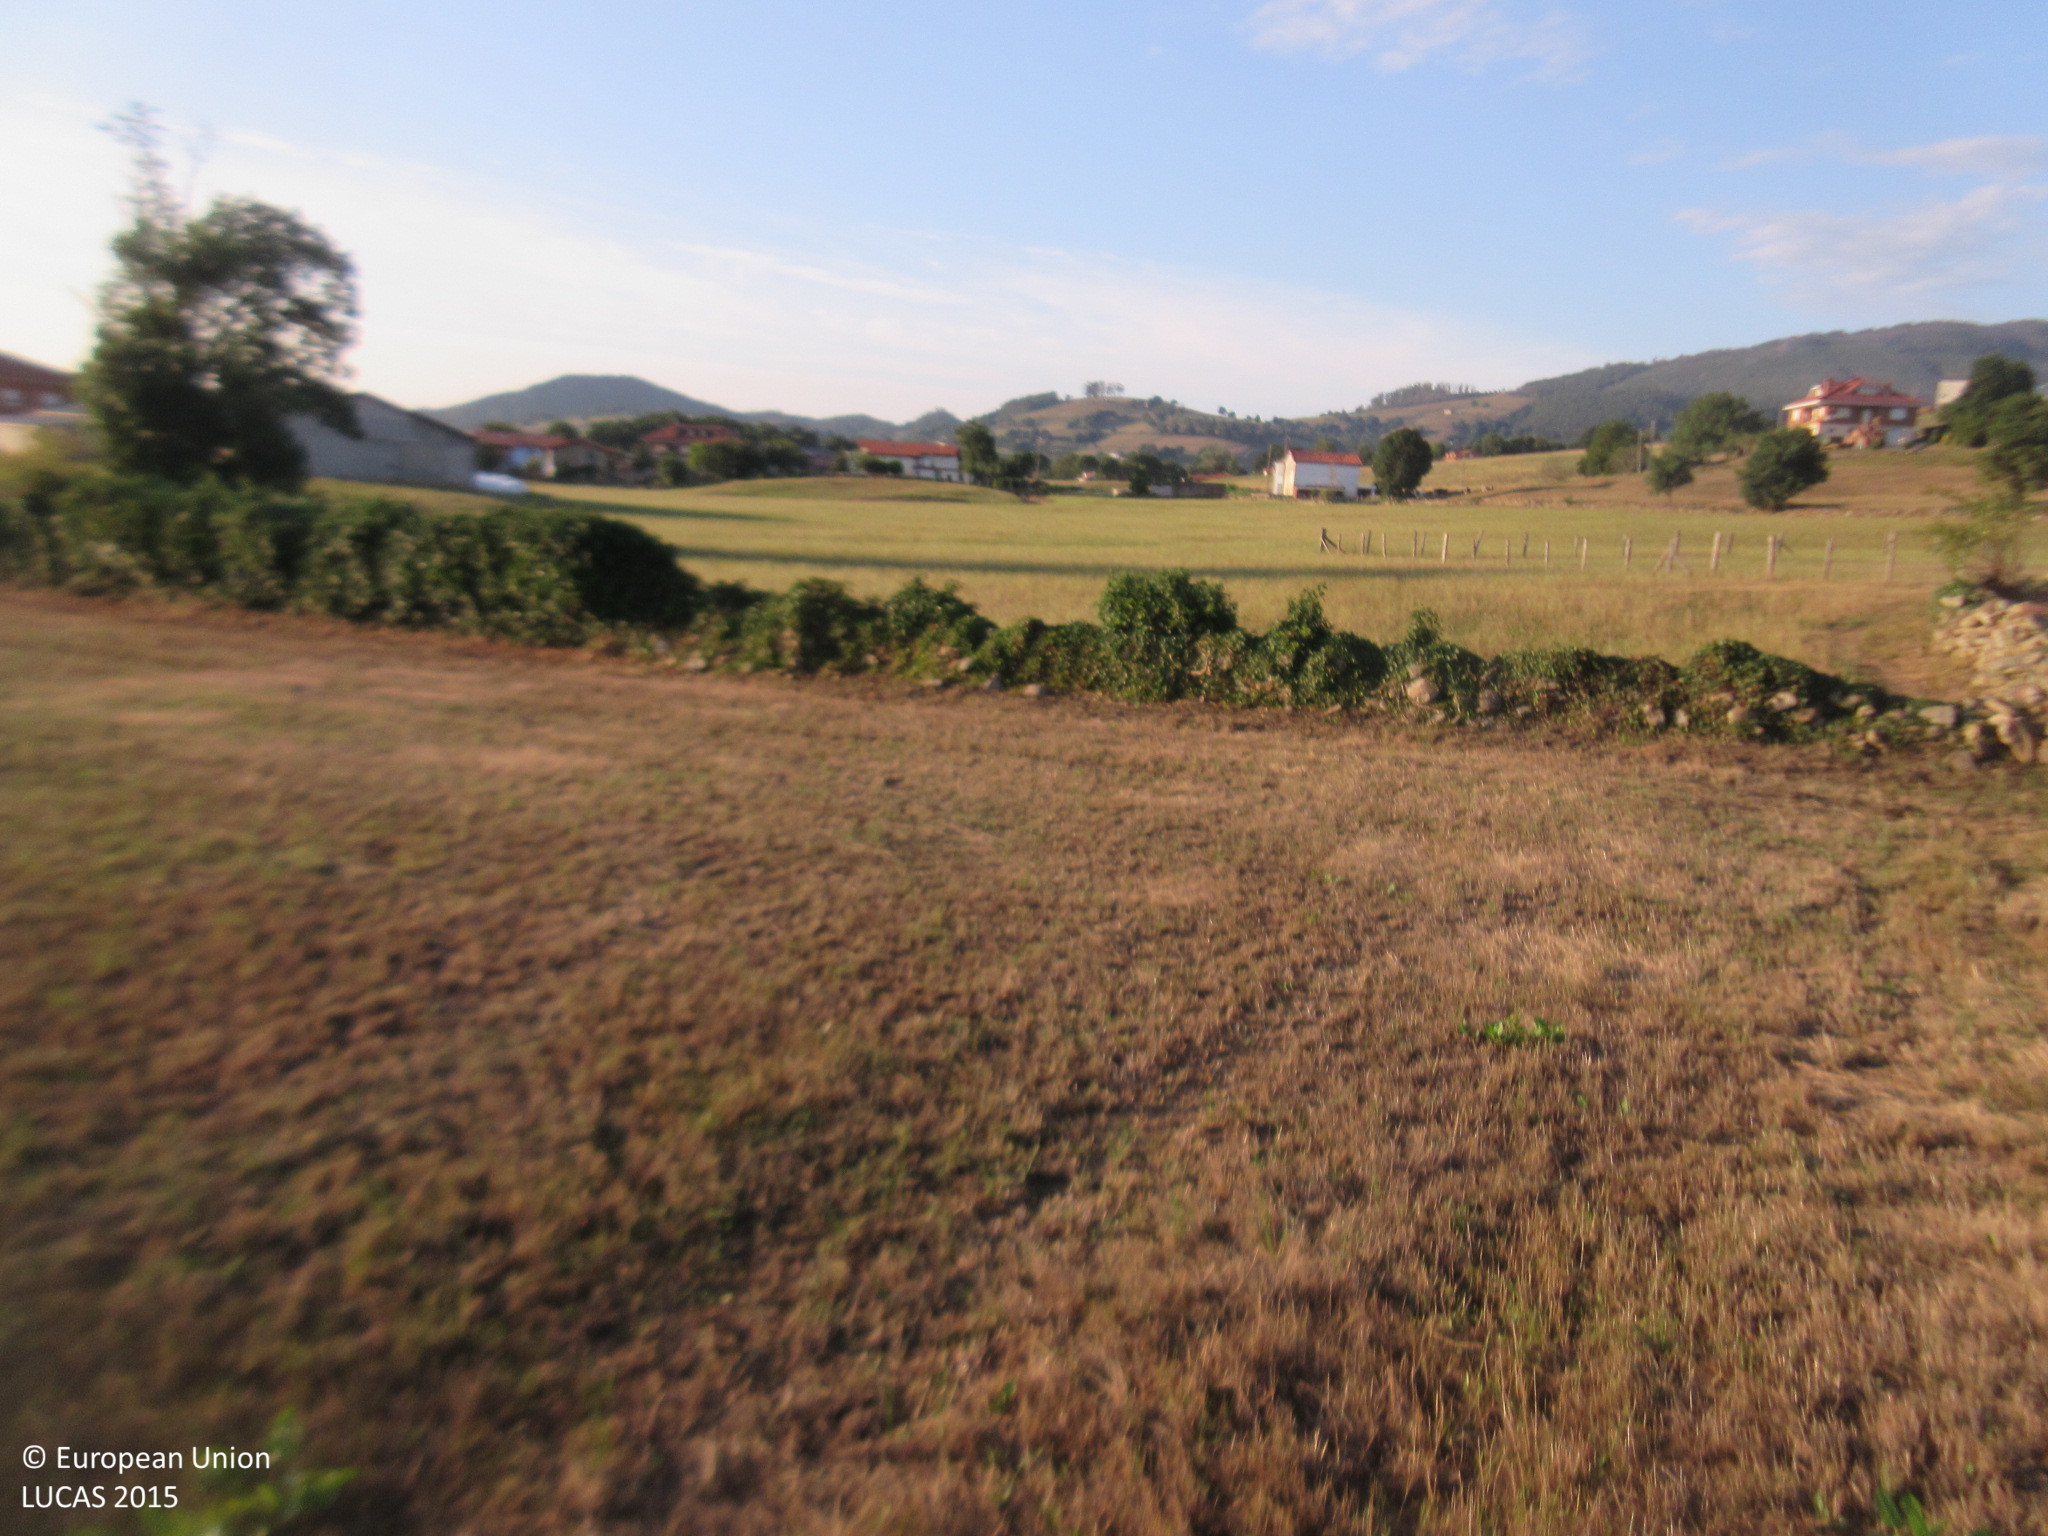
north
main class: Cropland
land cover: Temporary grasslands
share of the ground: > 75 %
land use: Agriculture (excluding fallow land and kitchen gardens)
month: July
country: ES
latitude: 43.2591
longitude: -3.9324
